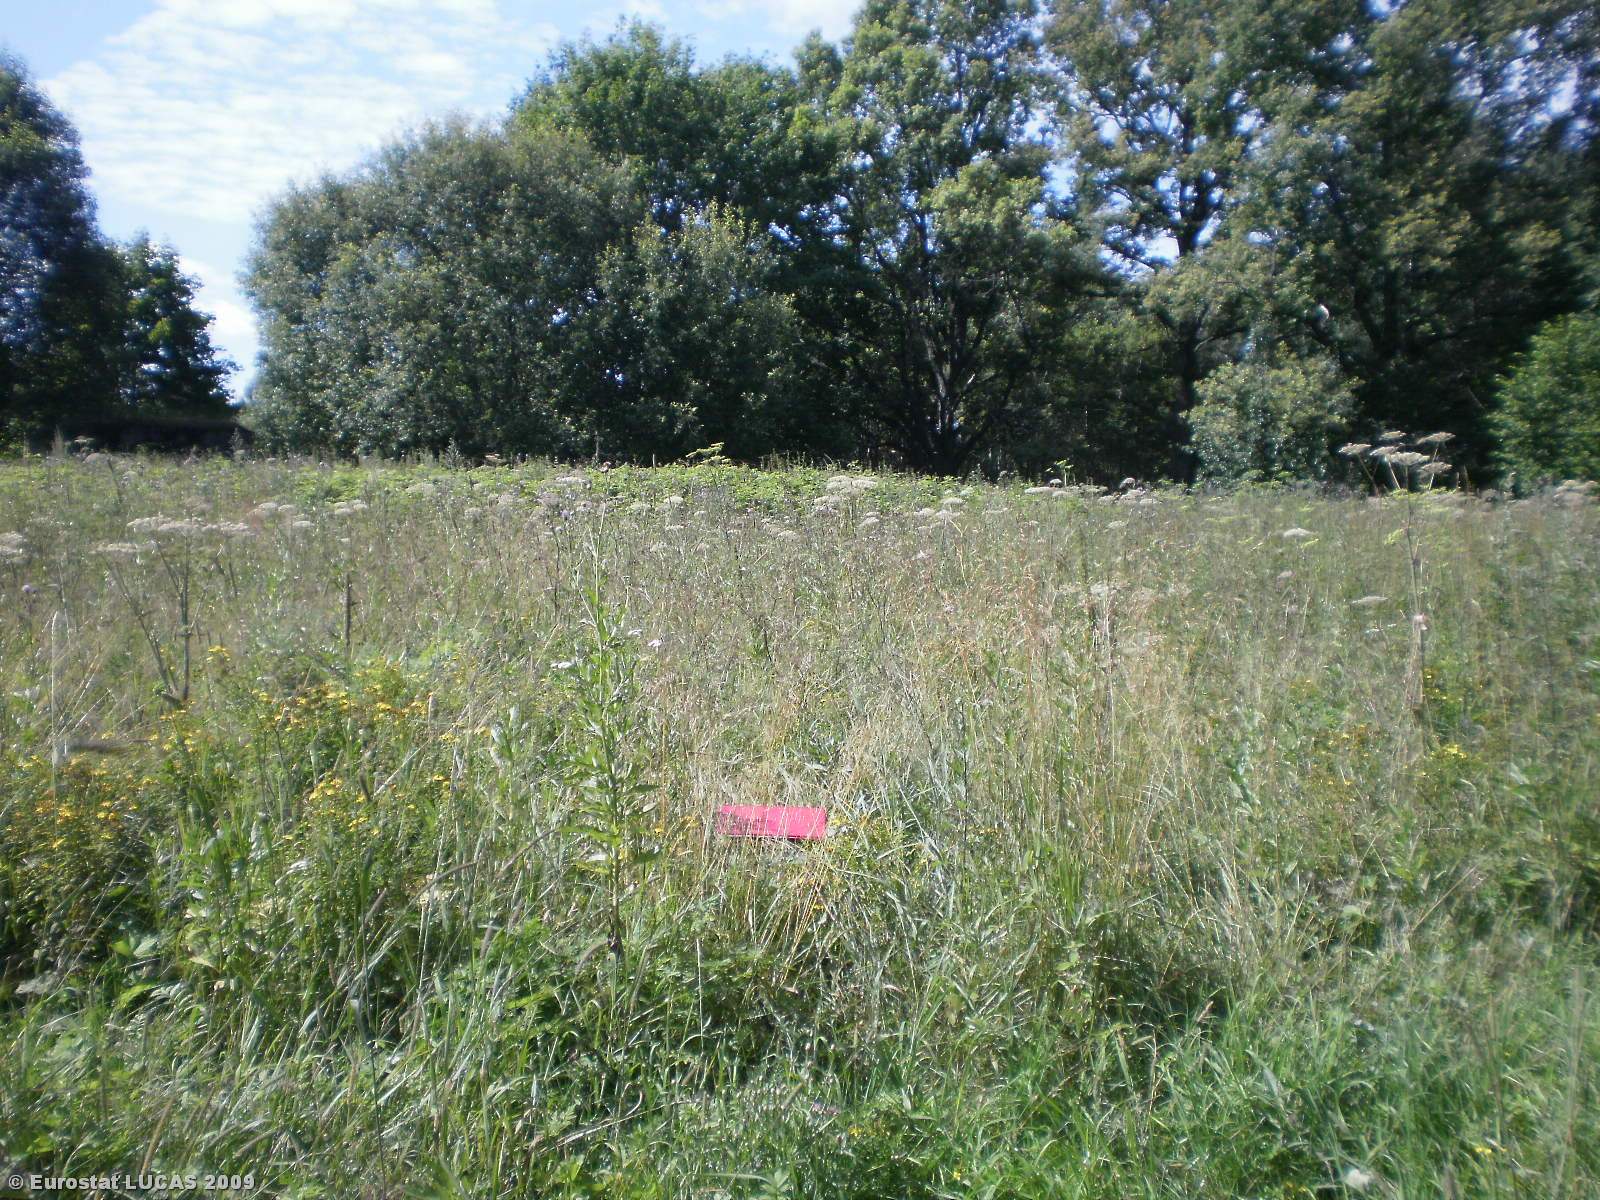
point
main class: Grassland
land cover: Grassland without tree/shrub cover
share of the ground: > 75 %
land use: Agriculture (excluding fallow land and kitchen gardens)
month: July
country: LT
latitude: 56.0584
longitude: 25.6883
